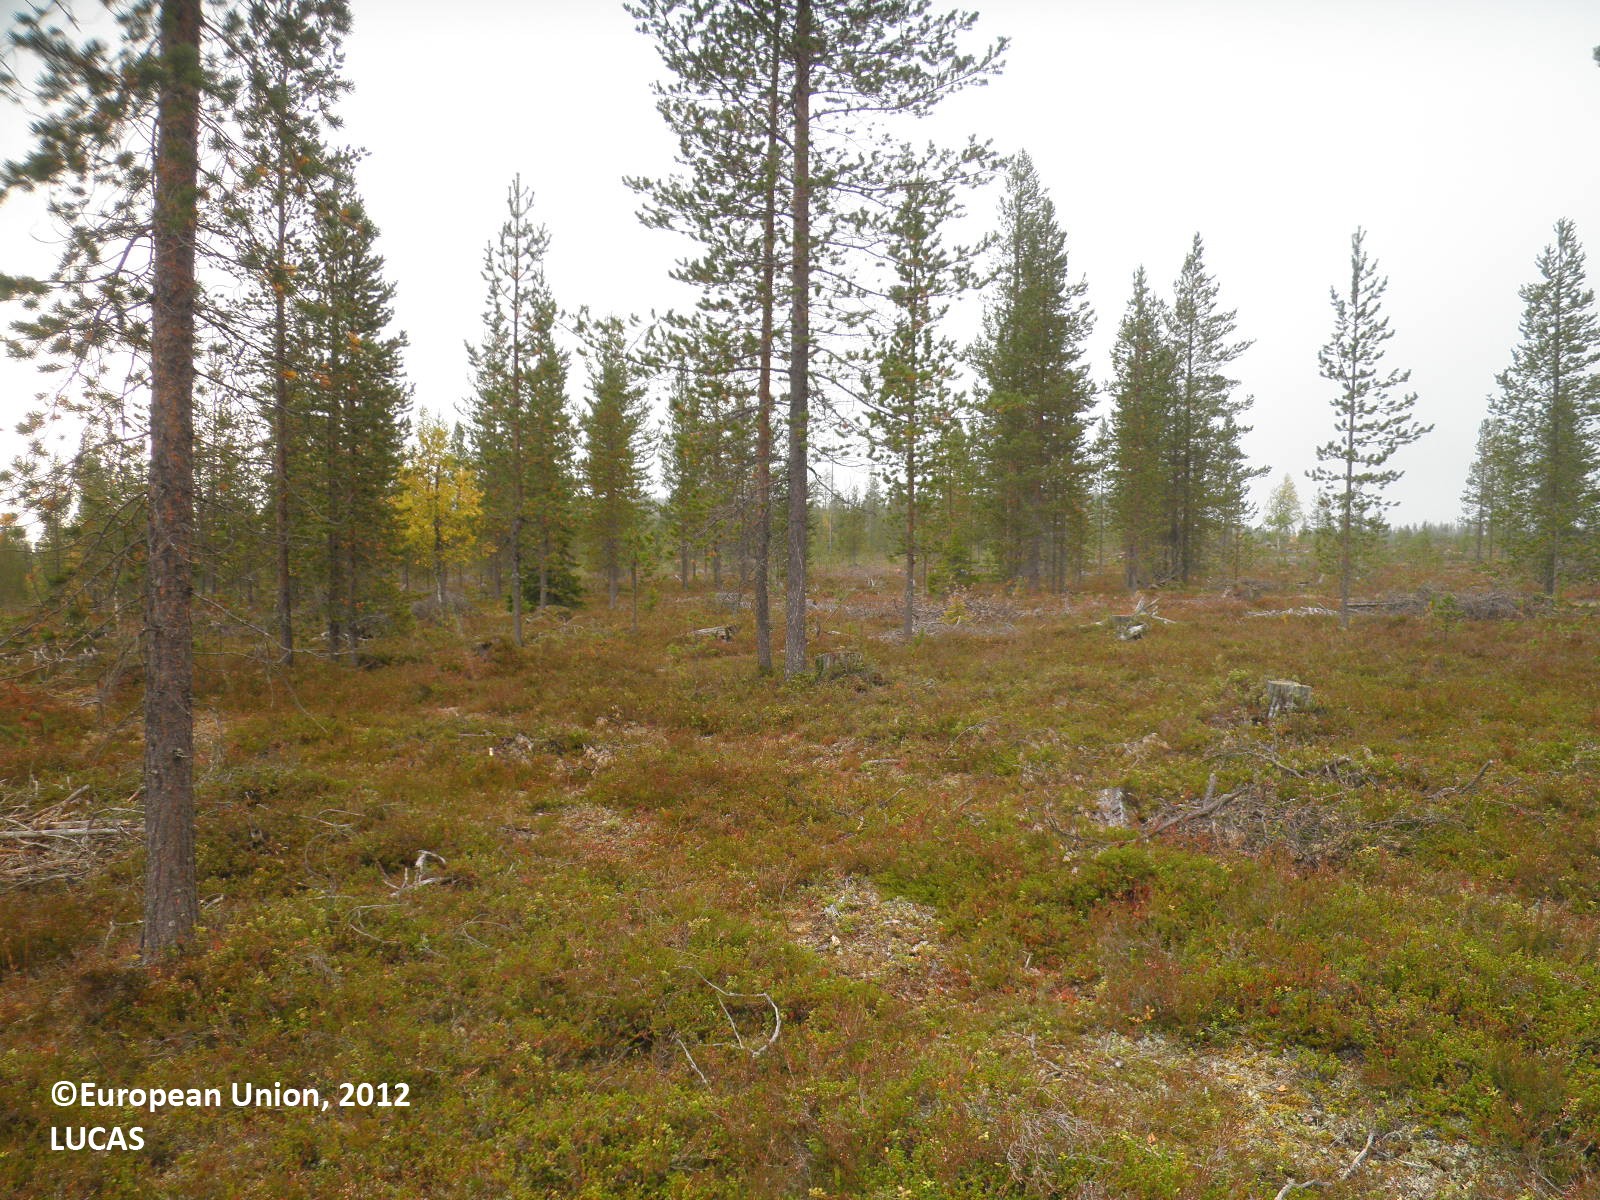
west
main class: Shrubland
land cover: Shrubland with sparse tree cover
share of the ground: > 75 %
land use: Forestry
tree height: > 5 m
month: September
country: FI
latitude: 67.4180
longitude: 28.4469
